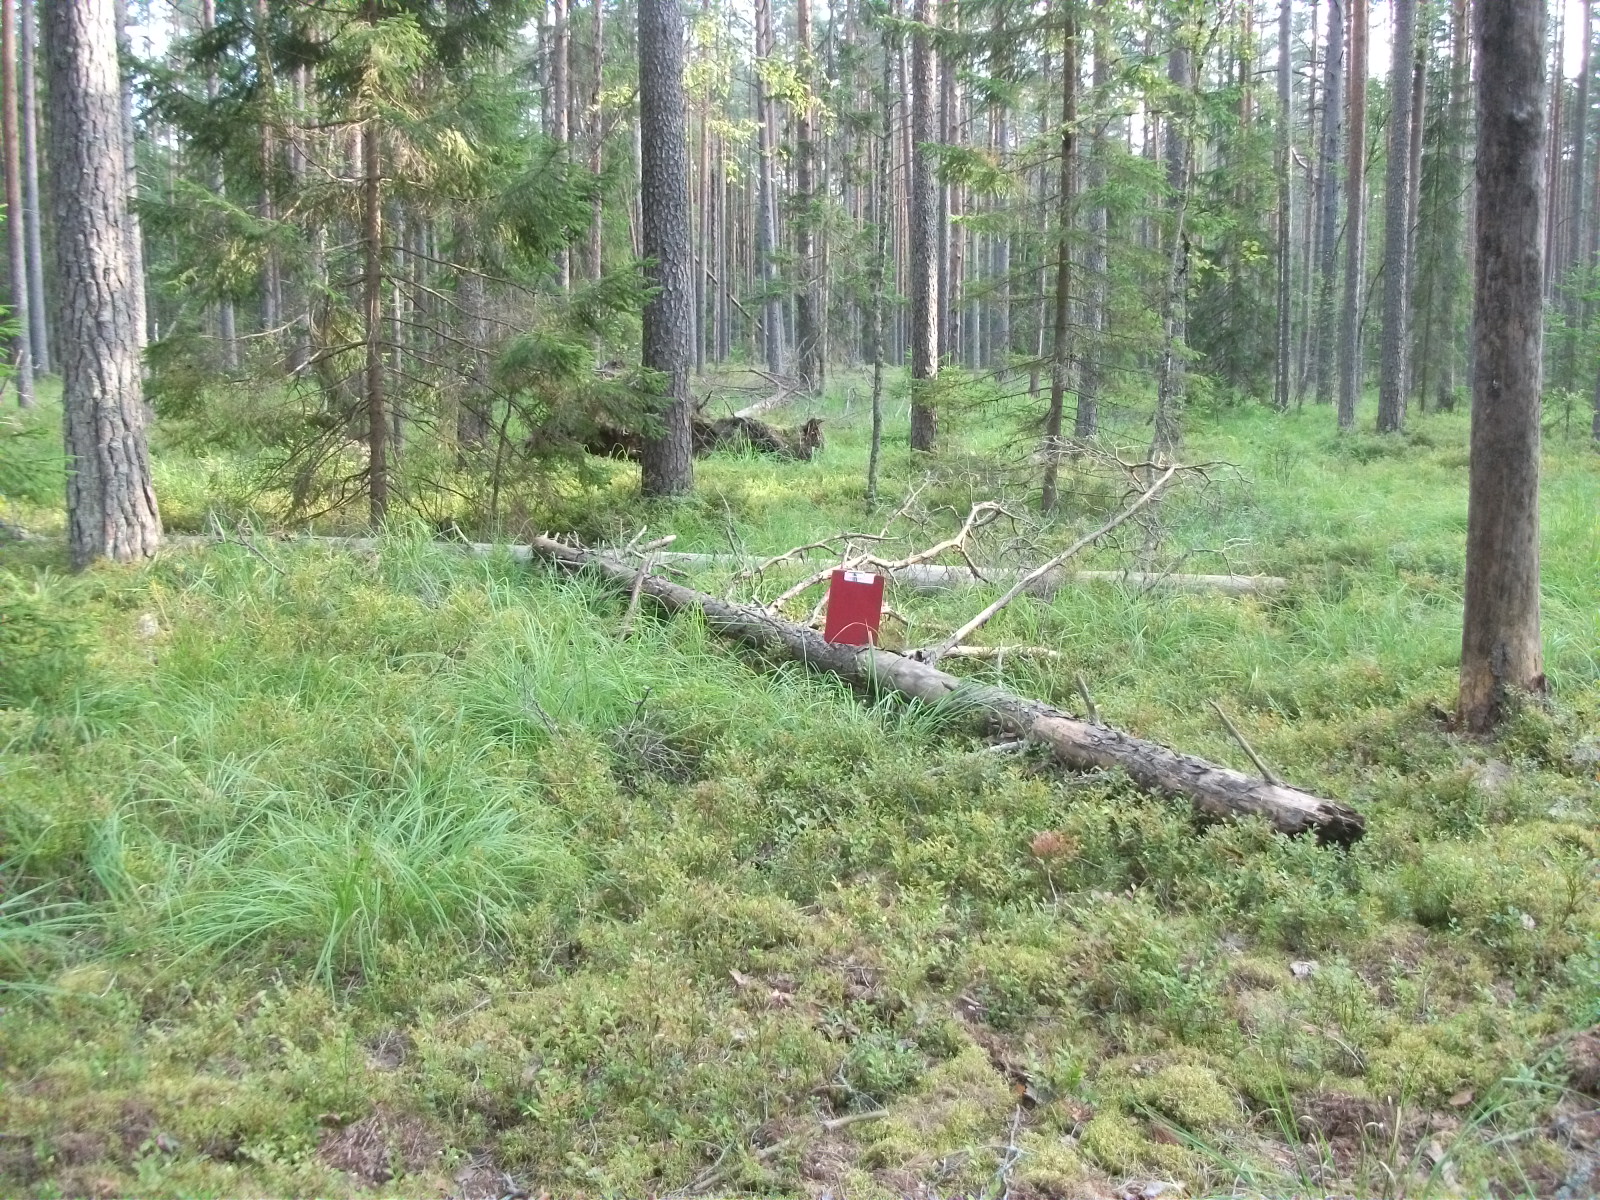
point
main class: Woodland
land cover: Other coniferous woodland
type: hemiboreal forest and nemoral coniferous forest and mixed broadleaved-coniferous forest
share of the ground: 50 - 75 %
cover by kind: coniferous forest trees 70 %, lichens and mosses 20 %, herbaceous plants 10 %
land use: Forestry
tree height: > 5 m
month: August
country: LV
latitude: 56.8533
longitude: 26.5287
